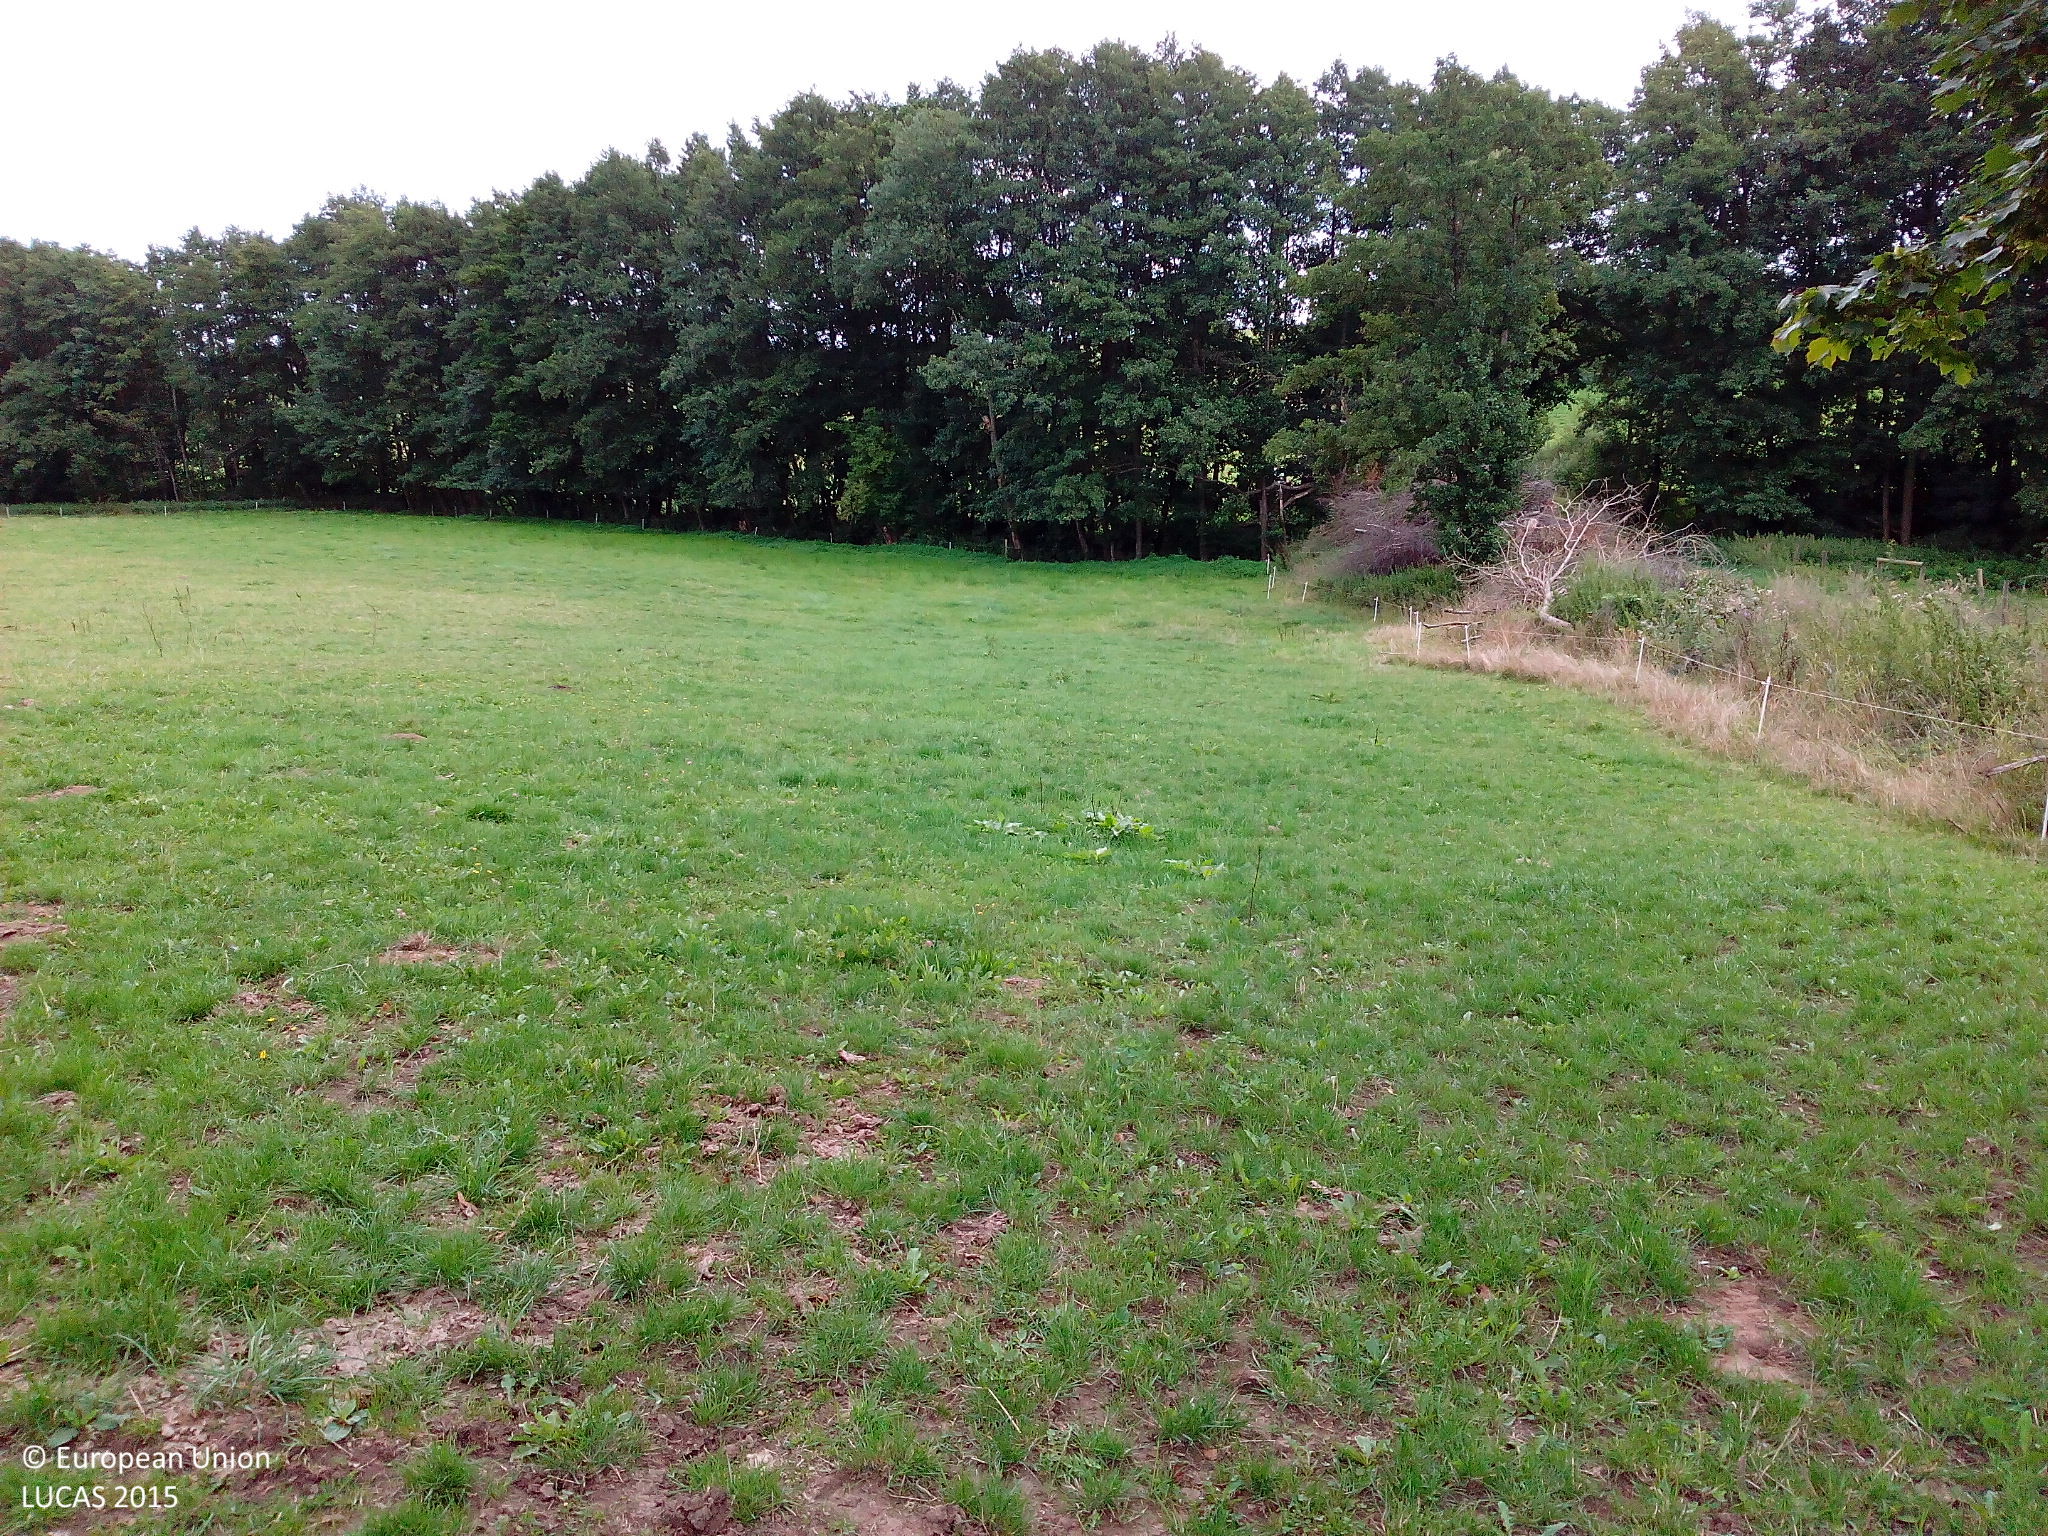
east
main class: Grassland
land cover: Grassland without tree/shrub cover
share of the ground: > 75 %
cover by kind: herbaceous plants 100 %
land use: Agriculture (excluding fallow land and kitchen gardens)
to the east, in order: Grassland without tree/shrub cover; Fences; Broadleaved woodland; Rivers and streams; Broadleaved woodland; Fences; Grassland without tree/shrub cover; Single bushes/trees; Fences; Grass margins; Paved roads, cycling and walking lanes; Grass margins; Ditches and canals; Grassland without tree/shrub cover
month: August
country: DE
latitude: 50.6493
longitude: 9.2506
